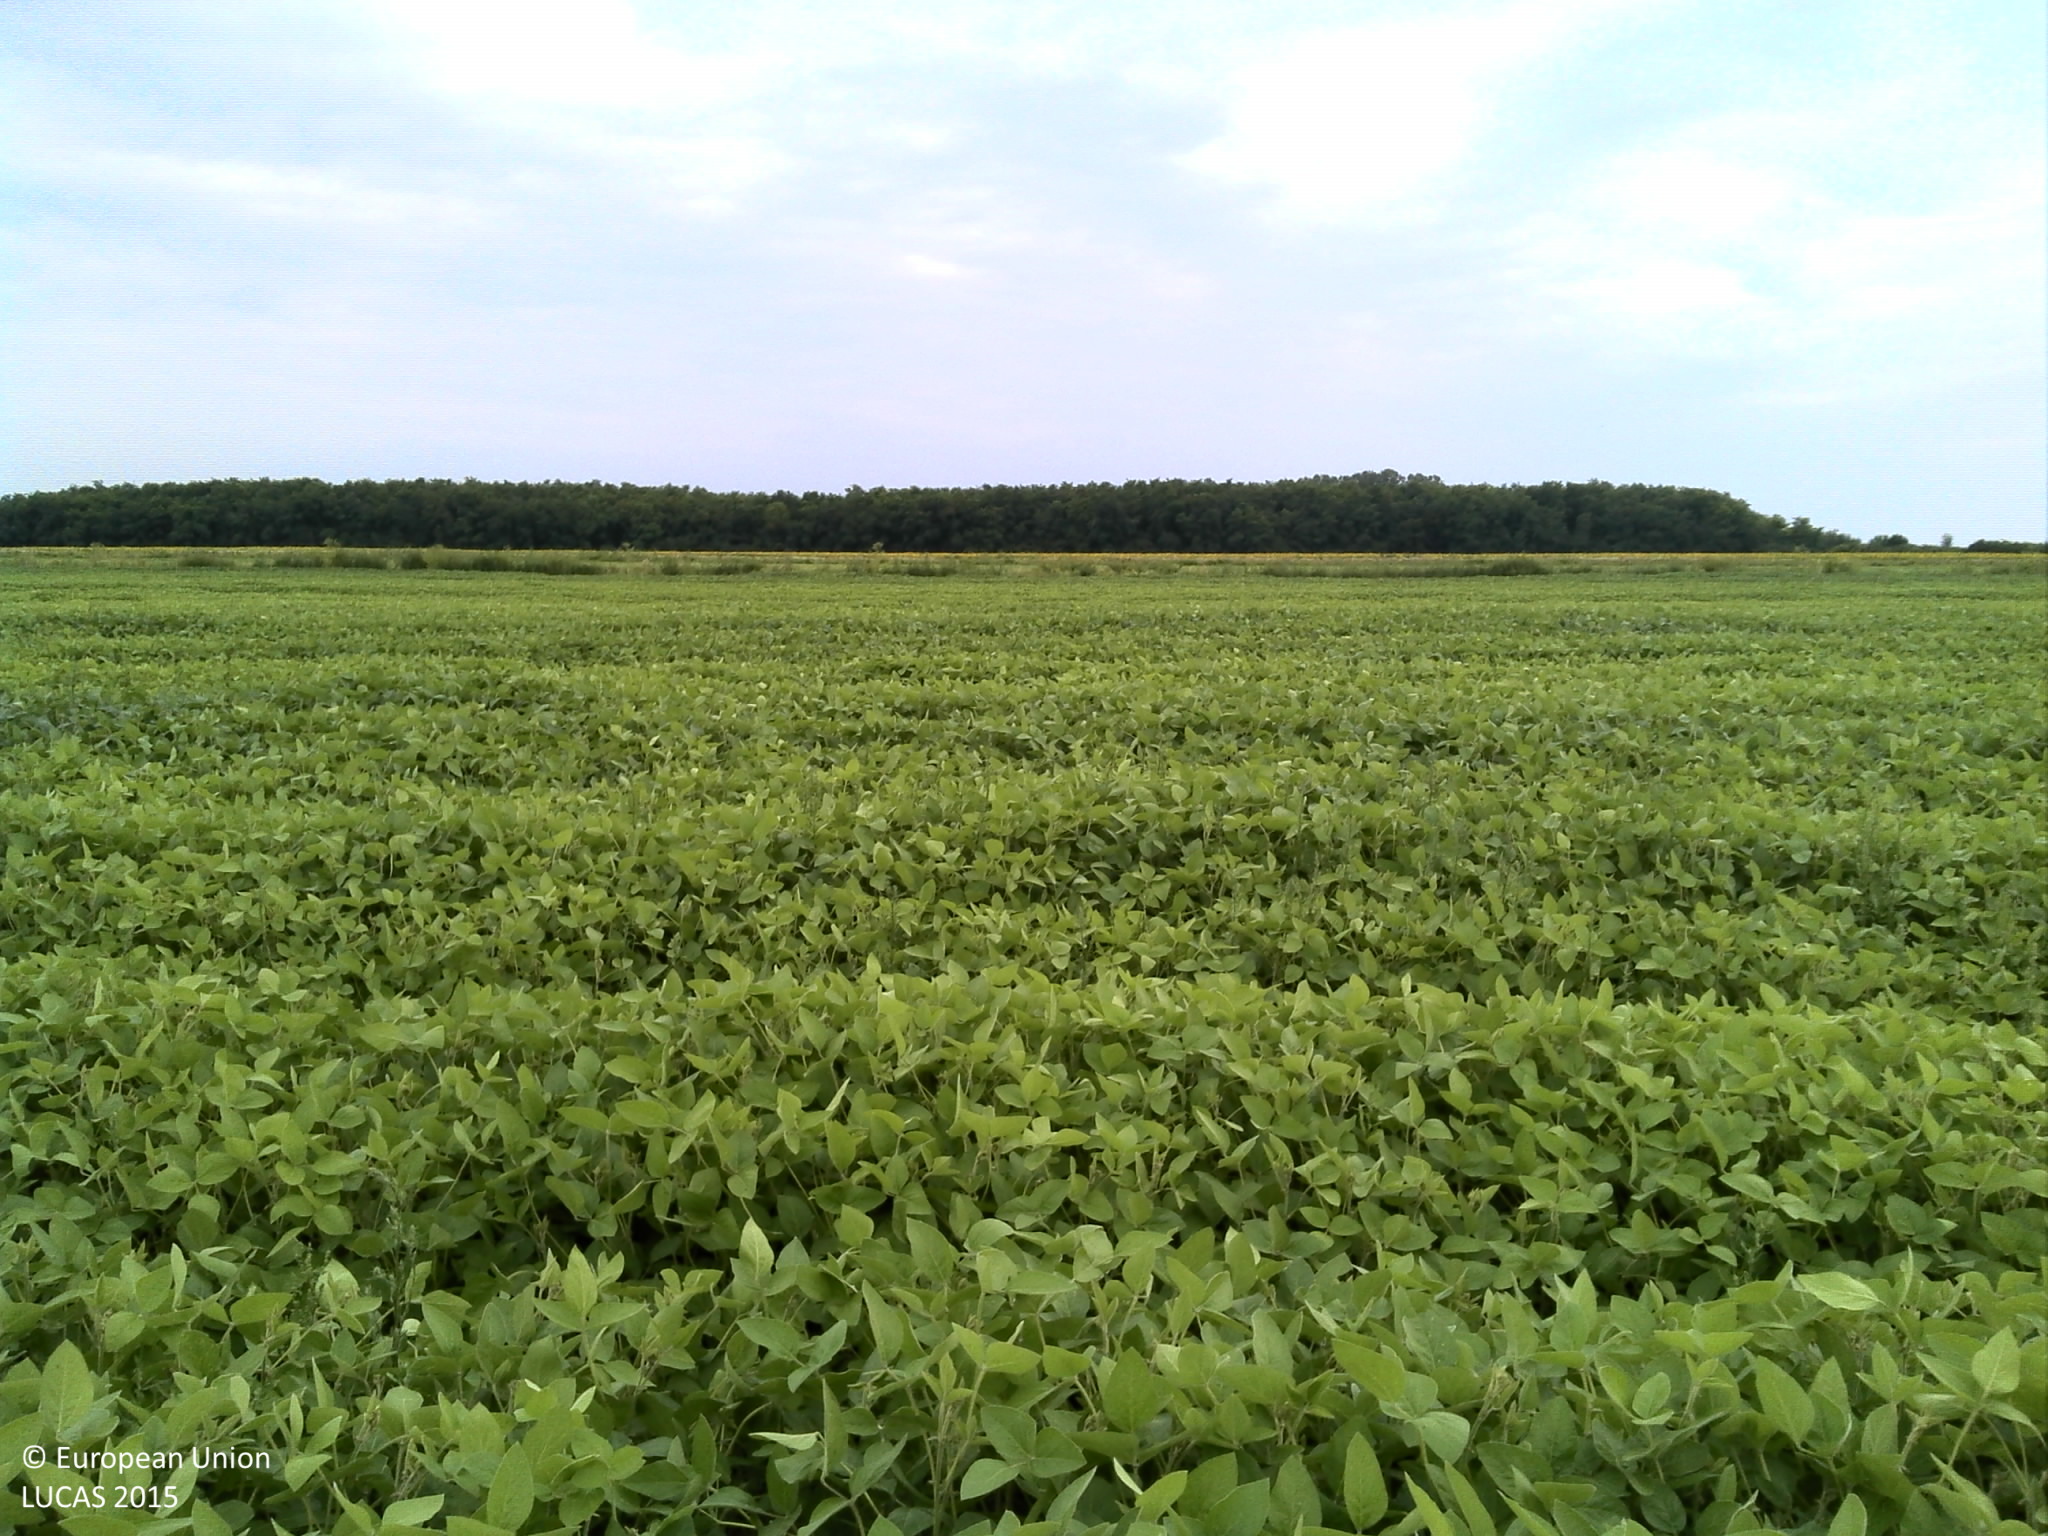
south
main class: Cropland
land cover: Soya
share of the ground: > 75 %
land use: Agriculture (excluding fallow land and kitchen gardens)
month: June
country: HR
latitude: 45.4860
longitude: 18.5147
